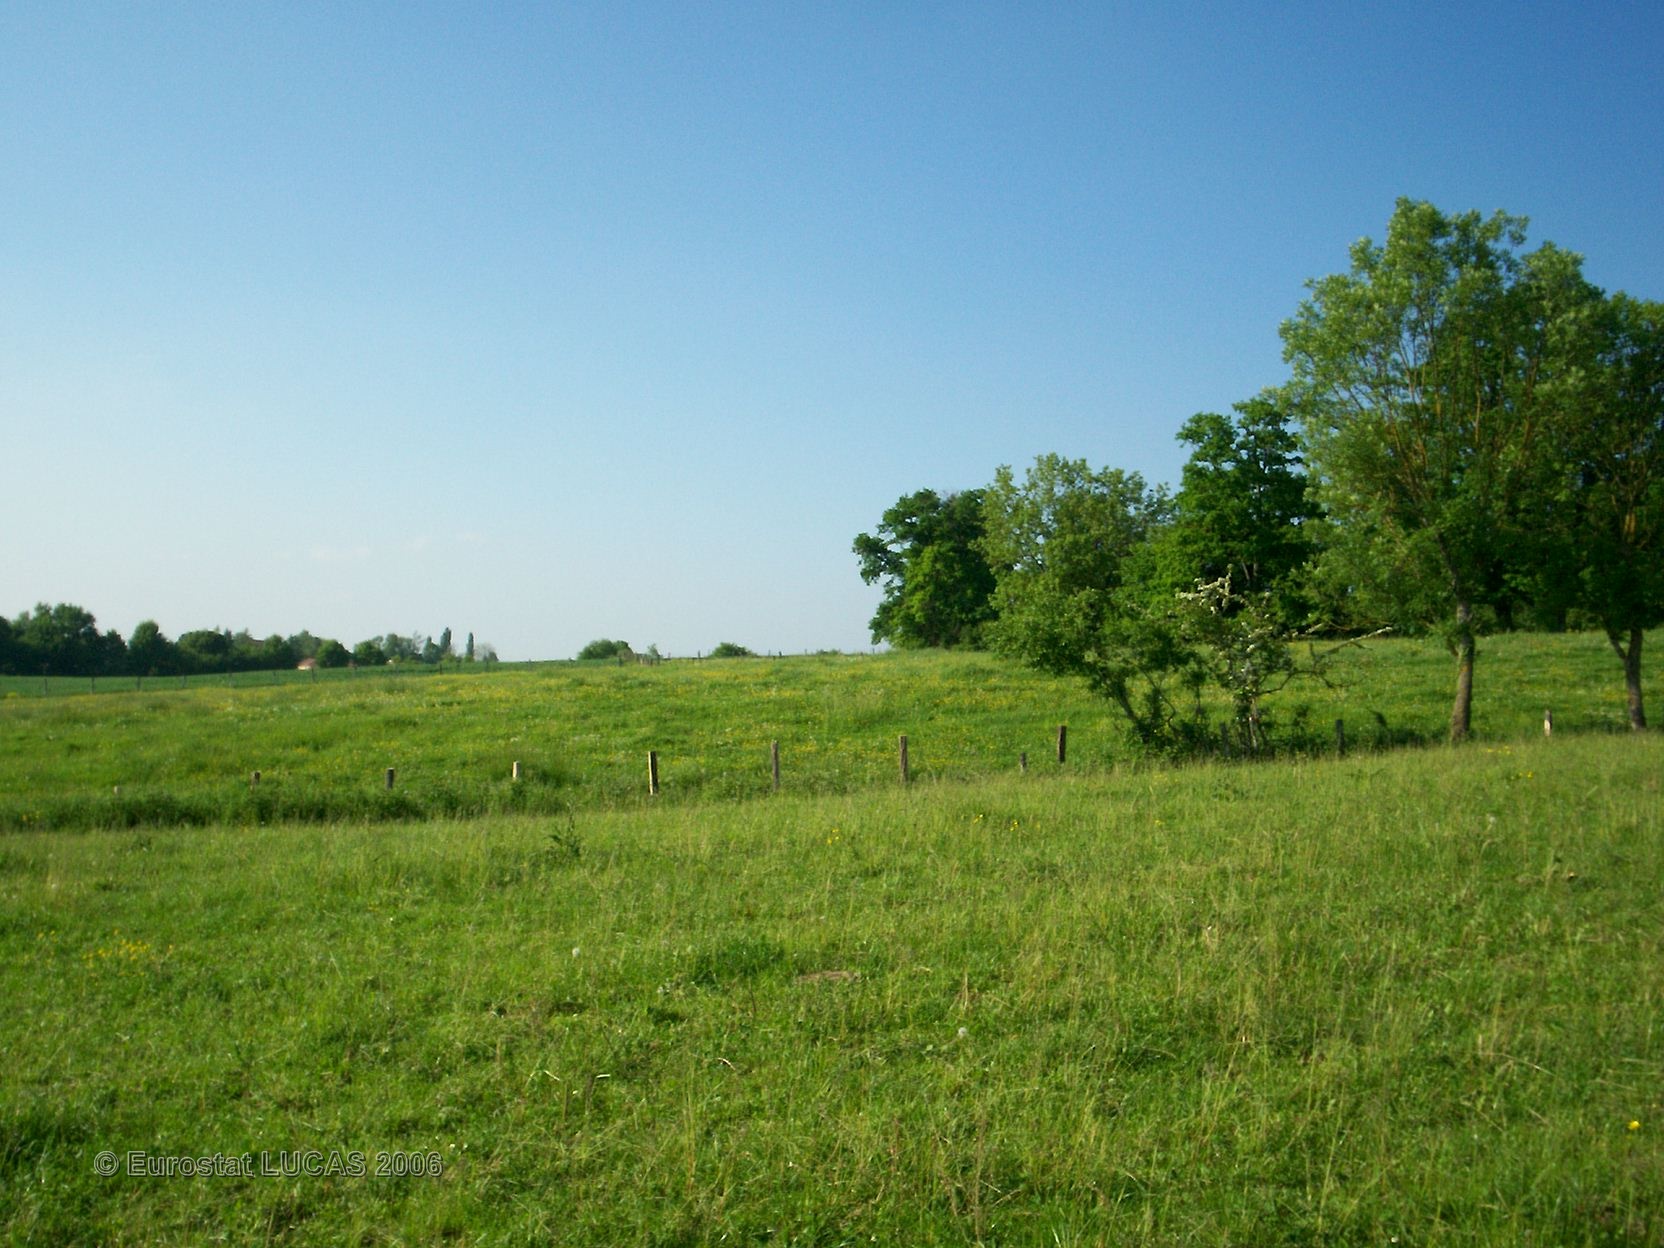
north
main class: Grassland
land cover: Grassland without tree/shrub cover
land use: Agriculture (excluding fallow land and kitchen gardens)
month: May
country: FR
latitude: 46.3497
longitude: 5.1556
